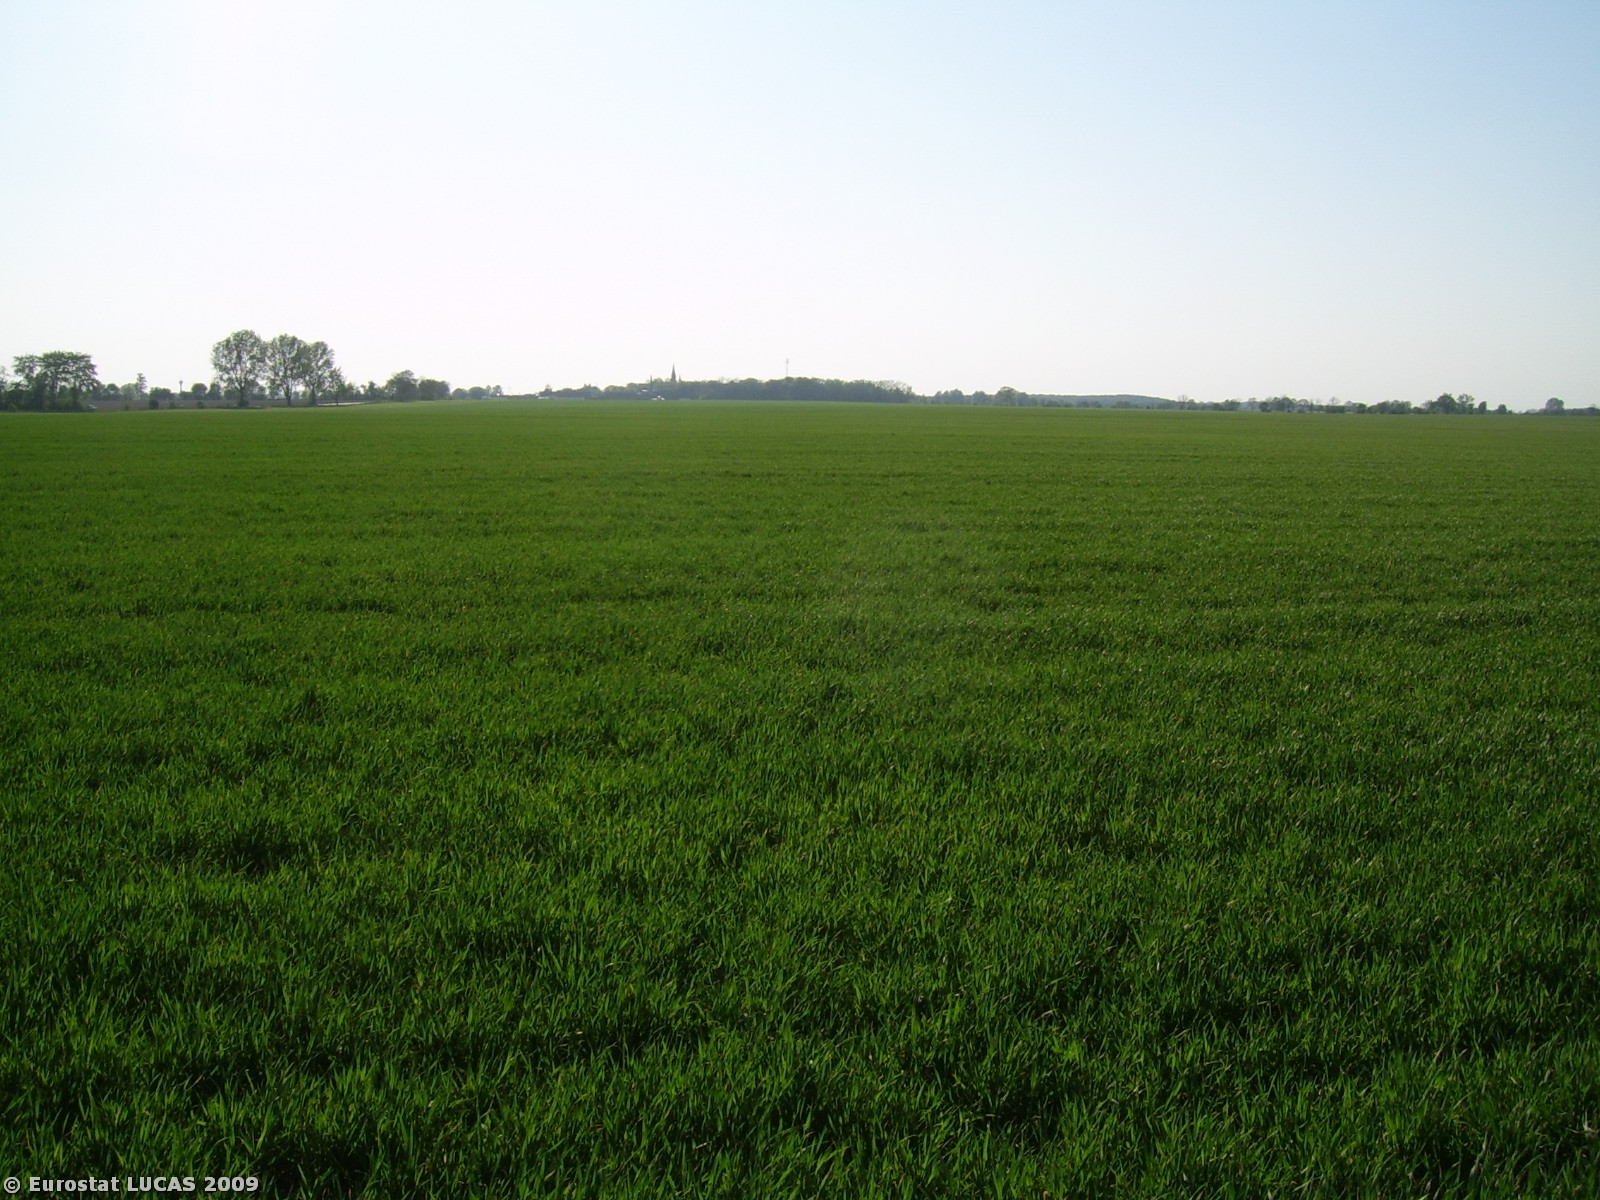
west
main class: Cropland
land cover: Common wheat
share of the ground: > 75 %
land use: Agriculture (excluding fallow land and kitchen gardens)
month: April
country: PL
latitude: 52.1394
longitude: 16.9207
